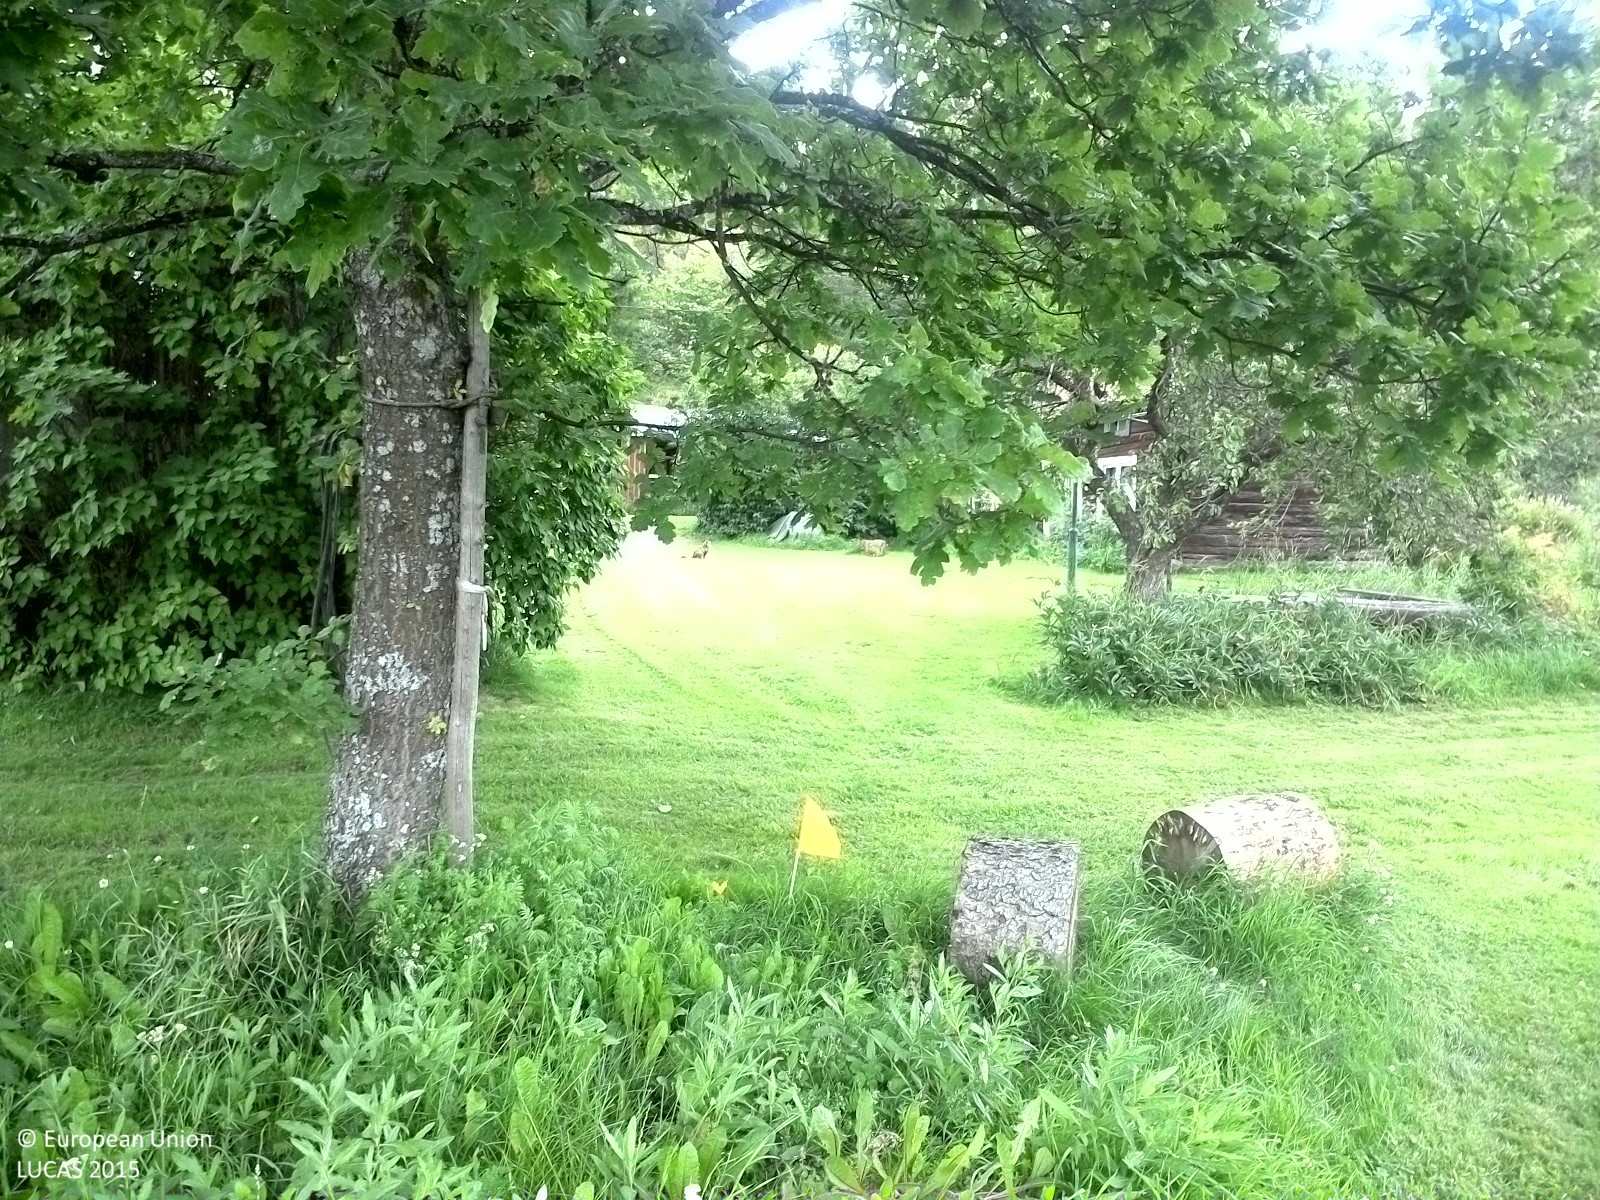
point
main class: Grassland
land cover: Grassland without tree/shrub cover
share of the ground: > 75 %
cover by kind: herbaceous plants 100 %
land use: Residential
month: August
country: SE
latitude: 62.4144
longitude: 17.3555
